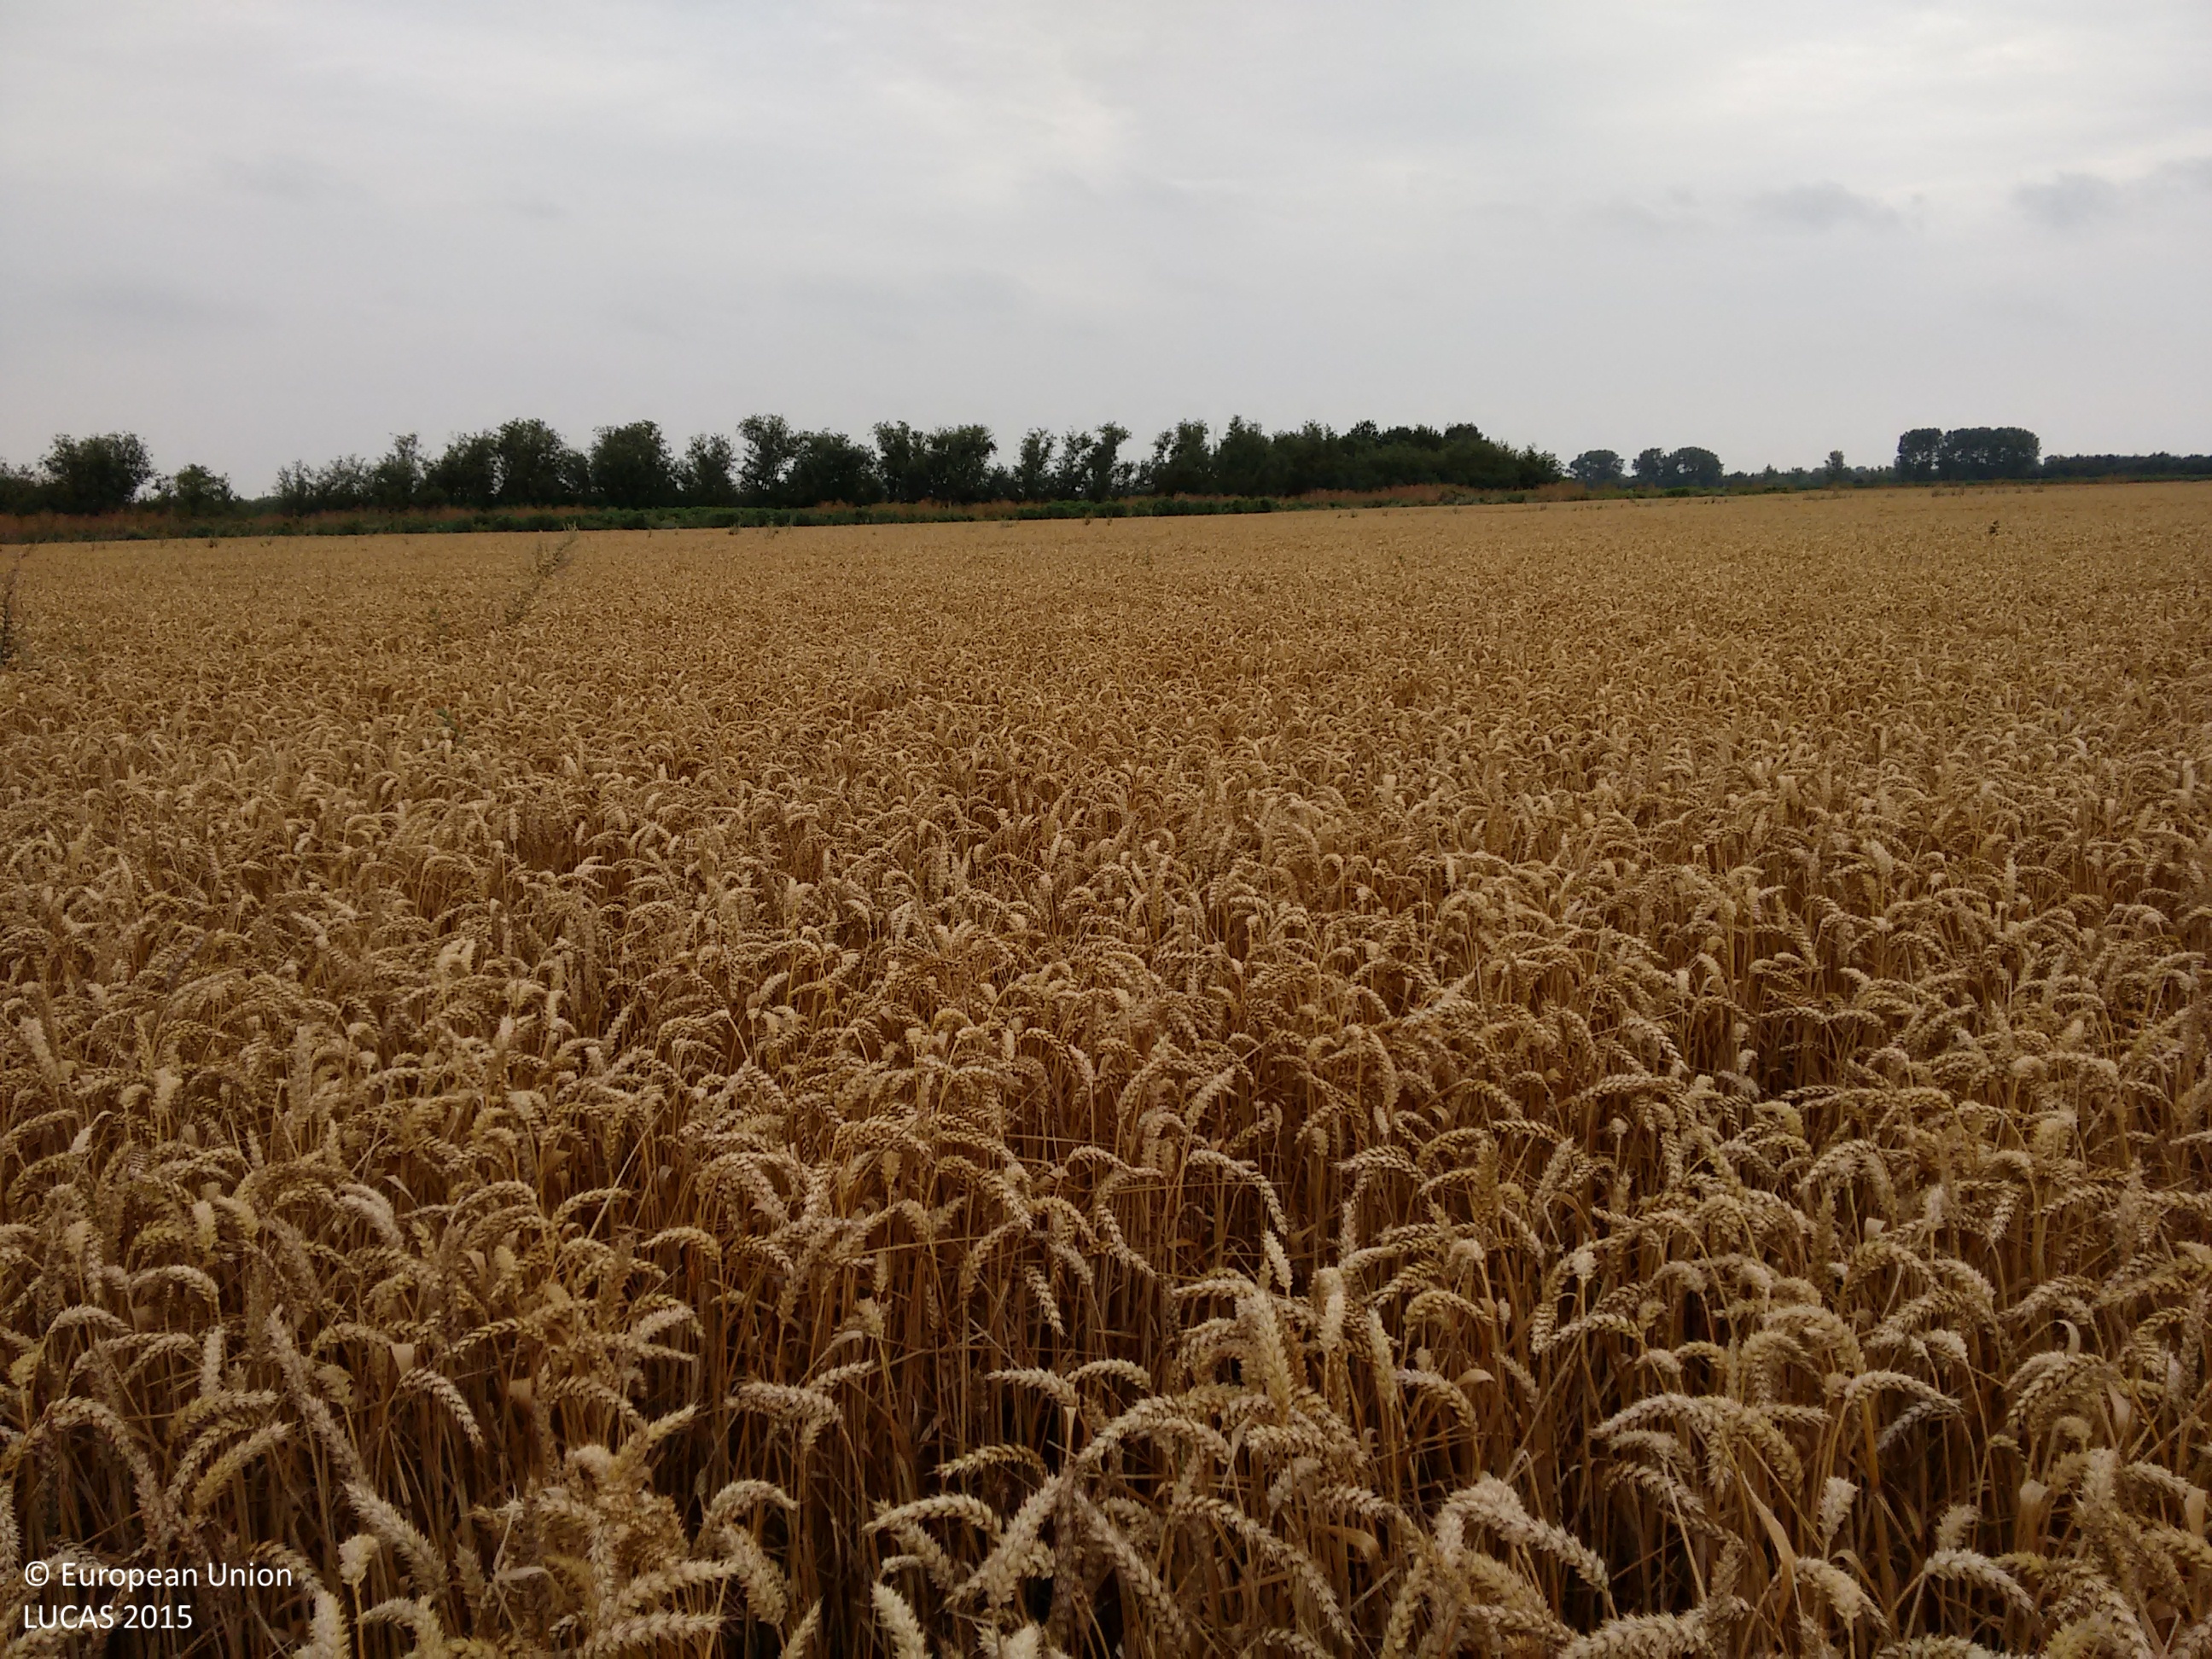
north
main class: Cropland
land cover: Common wheat
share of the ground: > 75 %
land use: Agriculture (excluding fallow land and kitchen gardens)
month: August
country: GB
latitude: 52.3485
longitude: 0.3850
